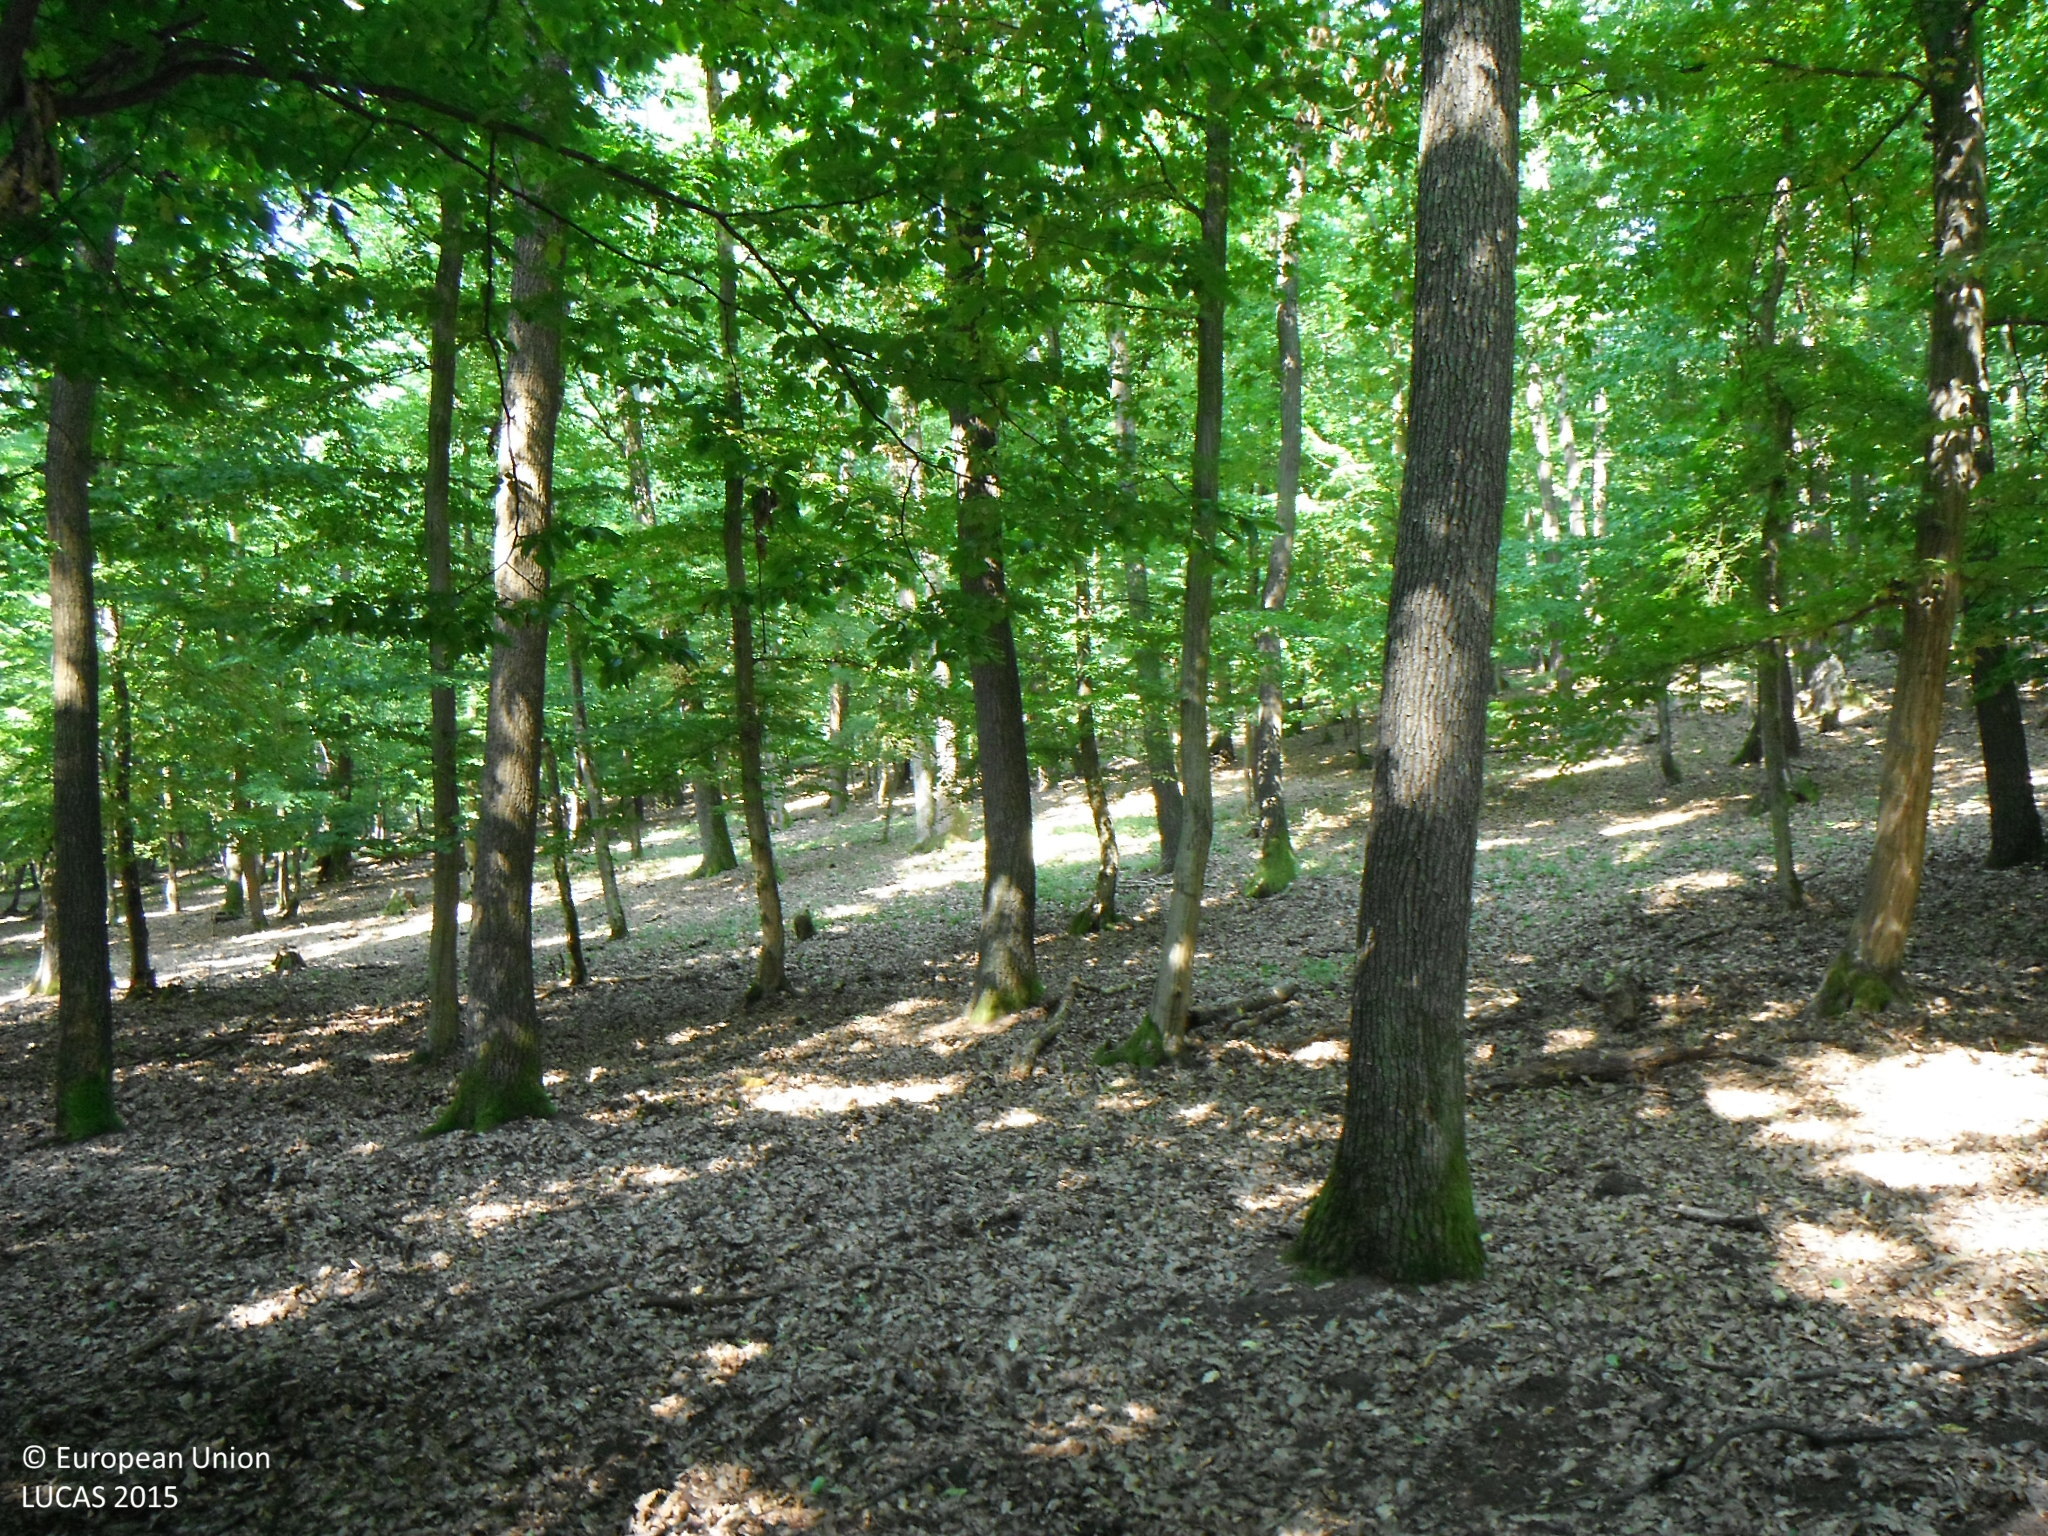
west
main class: Woodland
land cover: Broadleaved woodland
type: acidophilous oak and oak-birch forest
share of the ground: > 75 %
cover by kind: broadleaved forest trees 90 %, unconsolidated bare surface 10 %
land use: Forestry
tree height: > 5 m
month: July
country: SK
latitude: 48.3736
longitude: 20.1150
